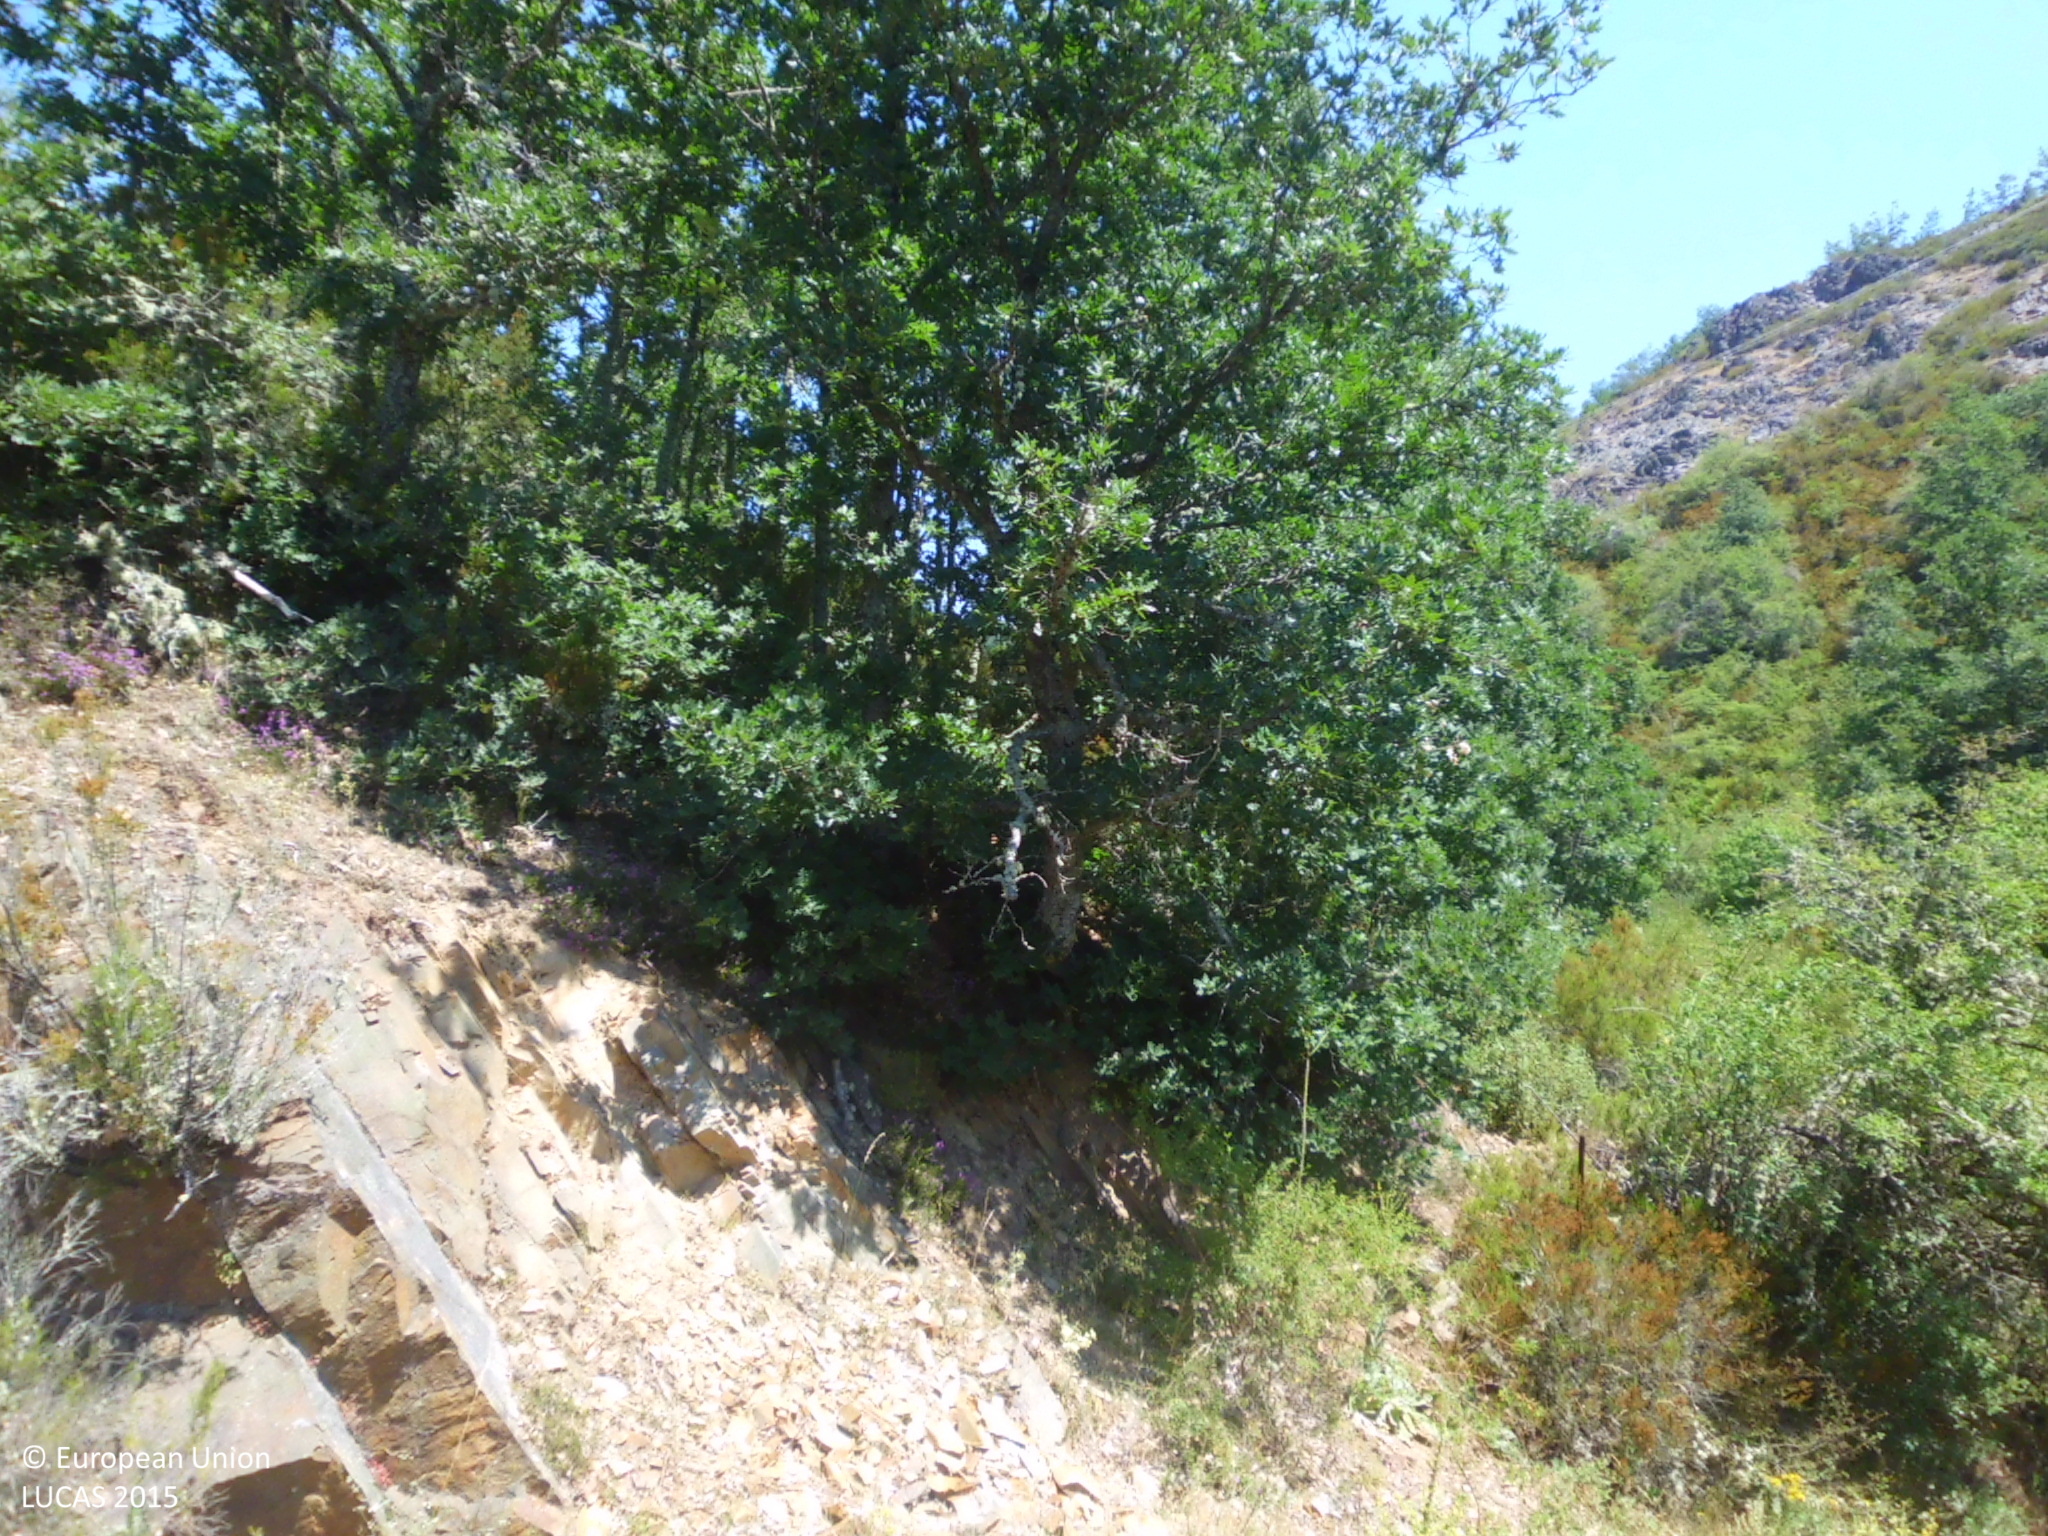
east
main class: Woodland
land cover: Broadleaved woodland
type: acidophilous oak and oak-birch forest
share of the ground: 50 - 75 %
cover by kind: broadleaved forest trees 60 %, shrubs 20 %, herbaceous plants 10 %, consolidated bare surface 10 %
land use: Semi-natural and natural areas not in use
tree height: > 5 m
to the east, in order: Broadleaved woodland; Shrubland with sparse tree cover
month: July
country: ES
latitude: 42.2623
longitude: -3.3286
